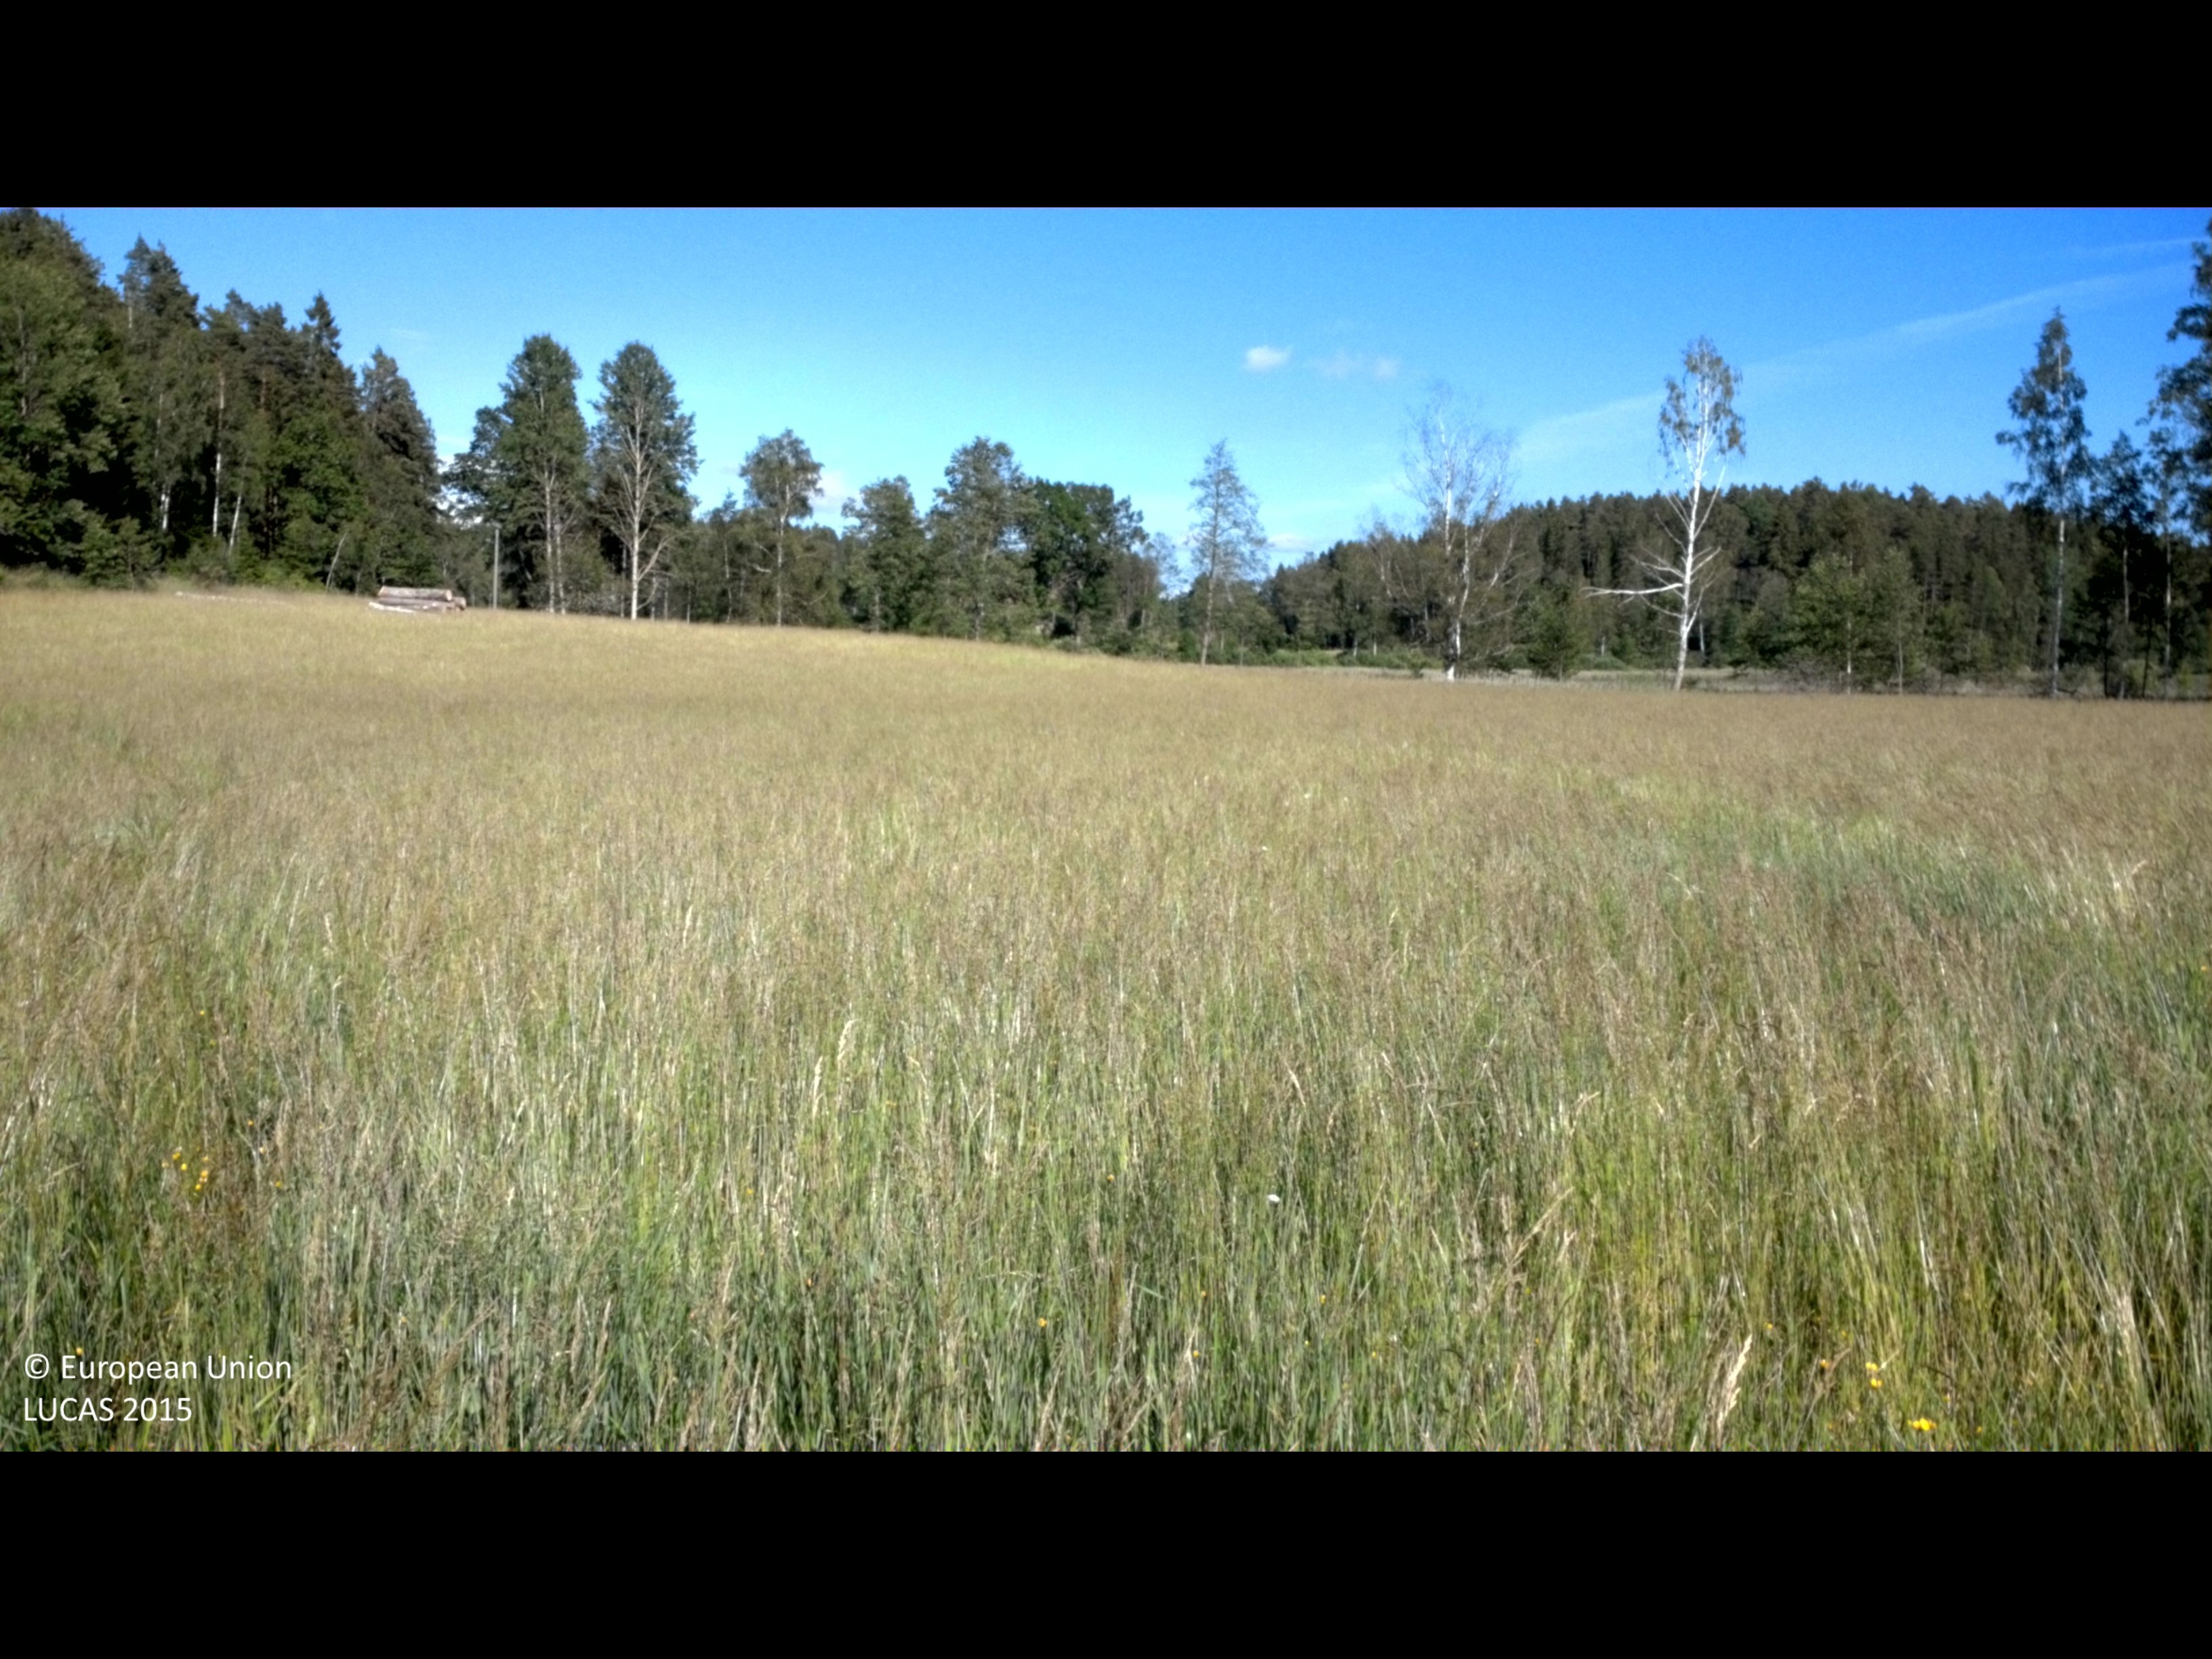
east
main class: Cropland
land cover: Other leguminous and mixtures for fodder
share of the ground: > 75 %
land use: Agriculture (excluding fallow land and kitchen gardens)
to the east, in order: Other leguminous and mixtures for fodder; Broadleaved woodland; Inland marshes; Broadleaved woodland
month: June
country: SE
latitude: 58.2235
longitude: 16.1423
